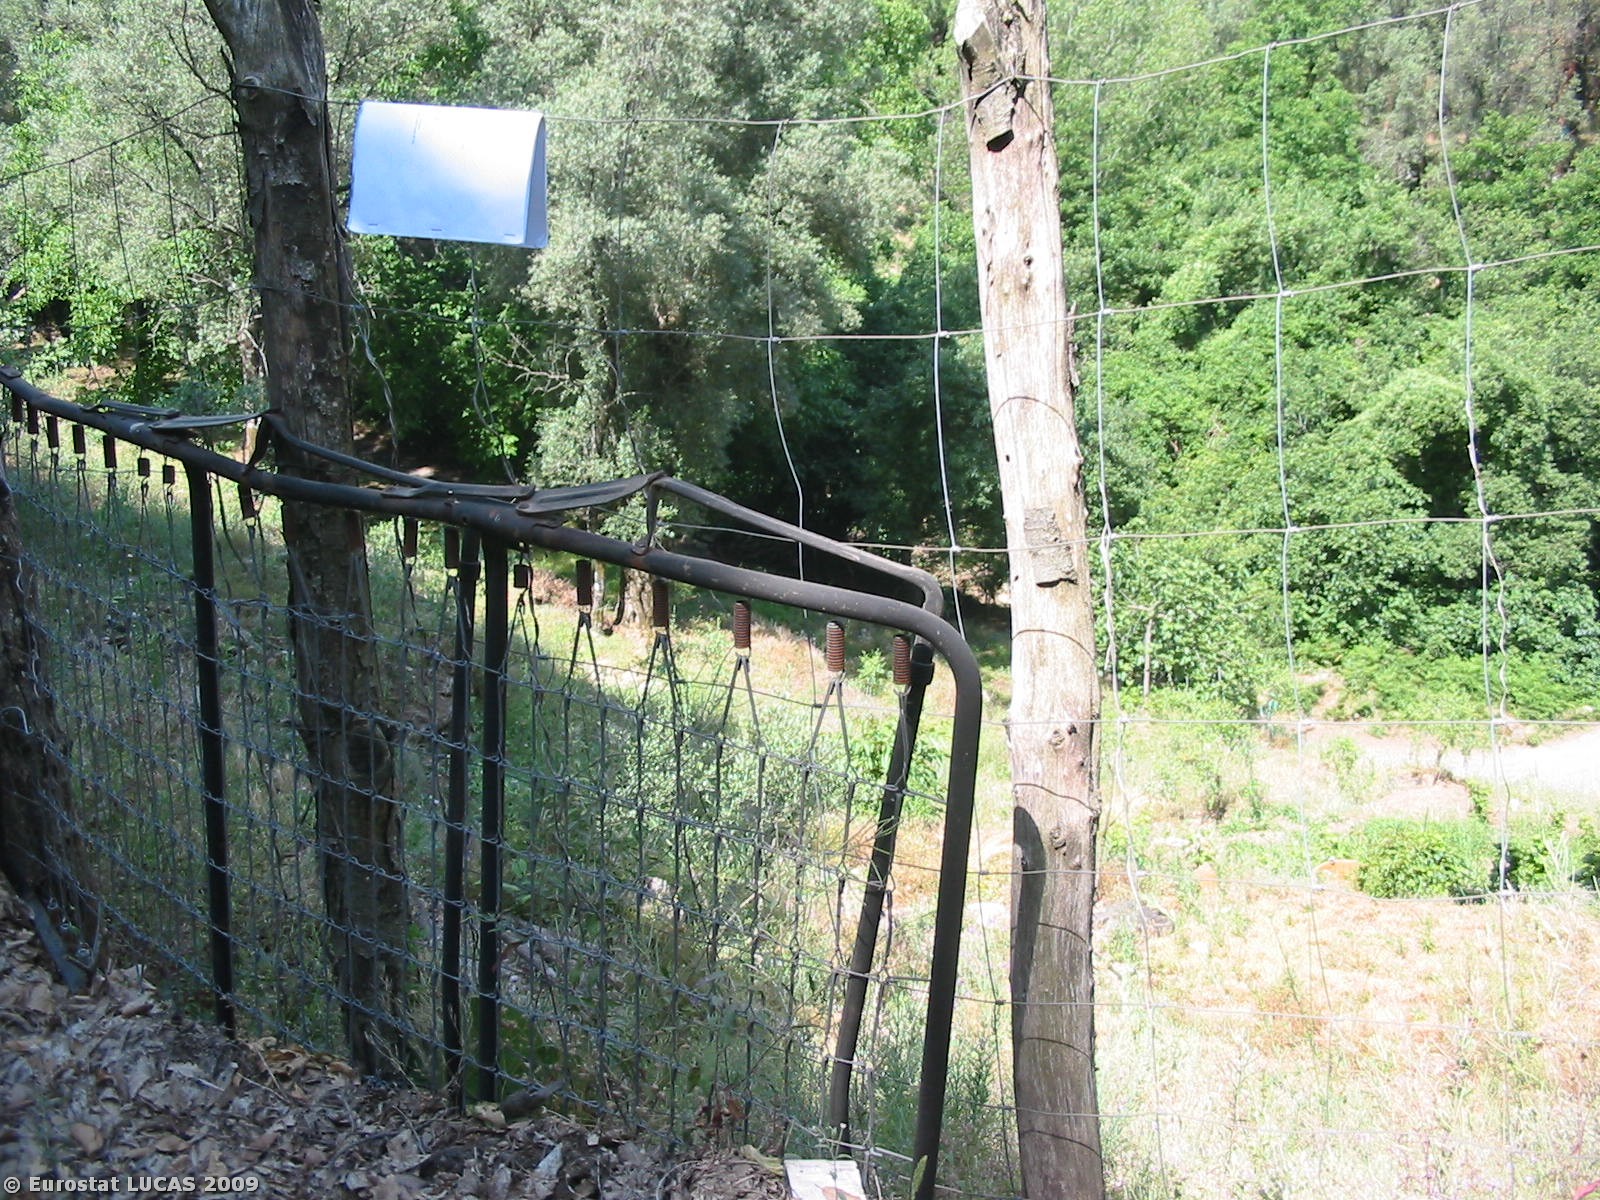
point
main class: Cropland
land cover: Olive groves
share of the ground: 50 - 75 %
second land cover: Spontaneously vegetated surfaces
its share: > 75 %
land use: Agriculture (excluding fallow land and kitchen gardens)
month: June
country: IT
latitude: 38.2348
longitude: 15.9389
